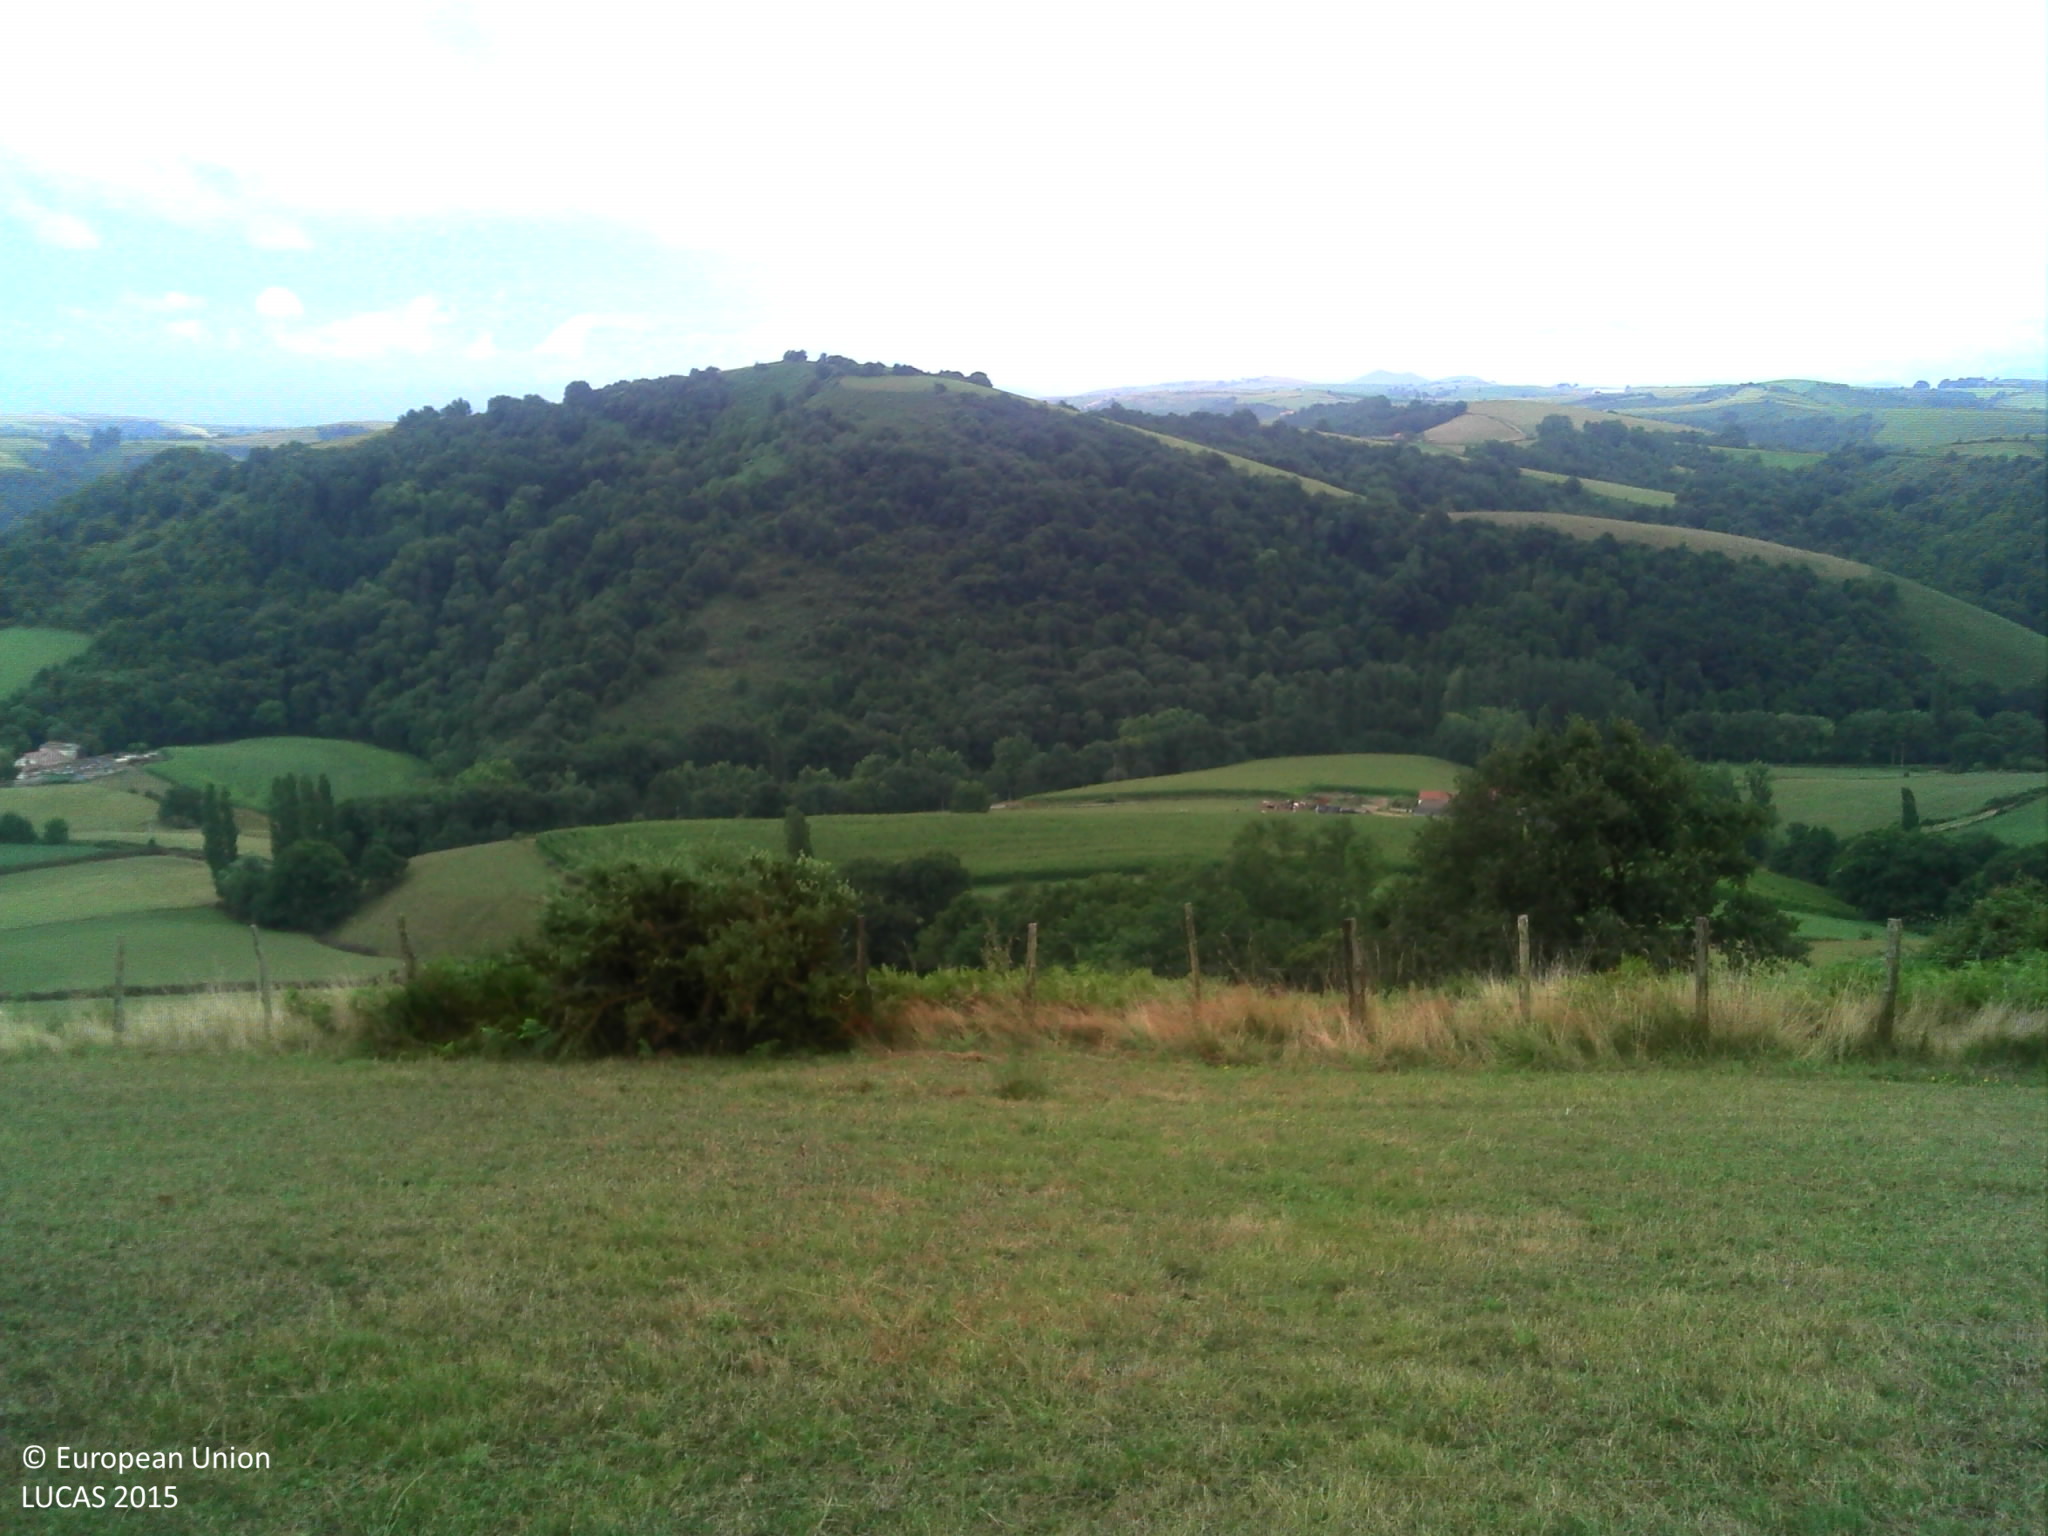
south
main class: Grassland
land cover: Grassland with sparse tree/shrub cover
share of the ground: > 75 %
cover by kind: herbaceous plants 90 %, broadleaved forest trees 5 %, shrubs 5 %
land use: Agriculture (excluding fallow land and kitchen gardens)
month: August
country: FR
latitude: 43.4004
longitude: -1.1640
